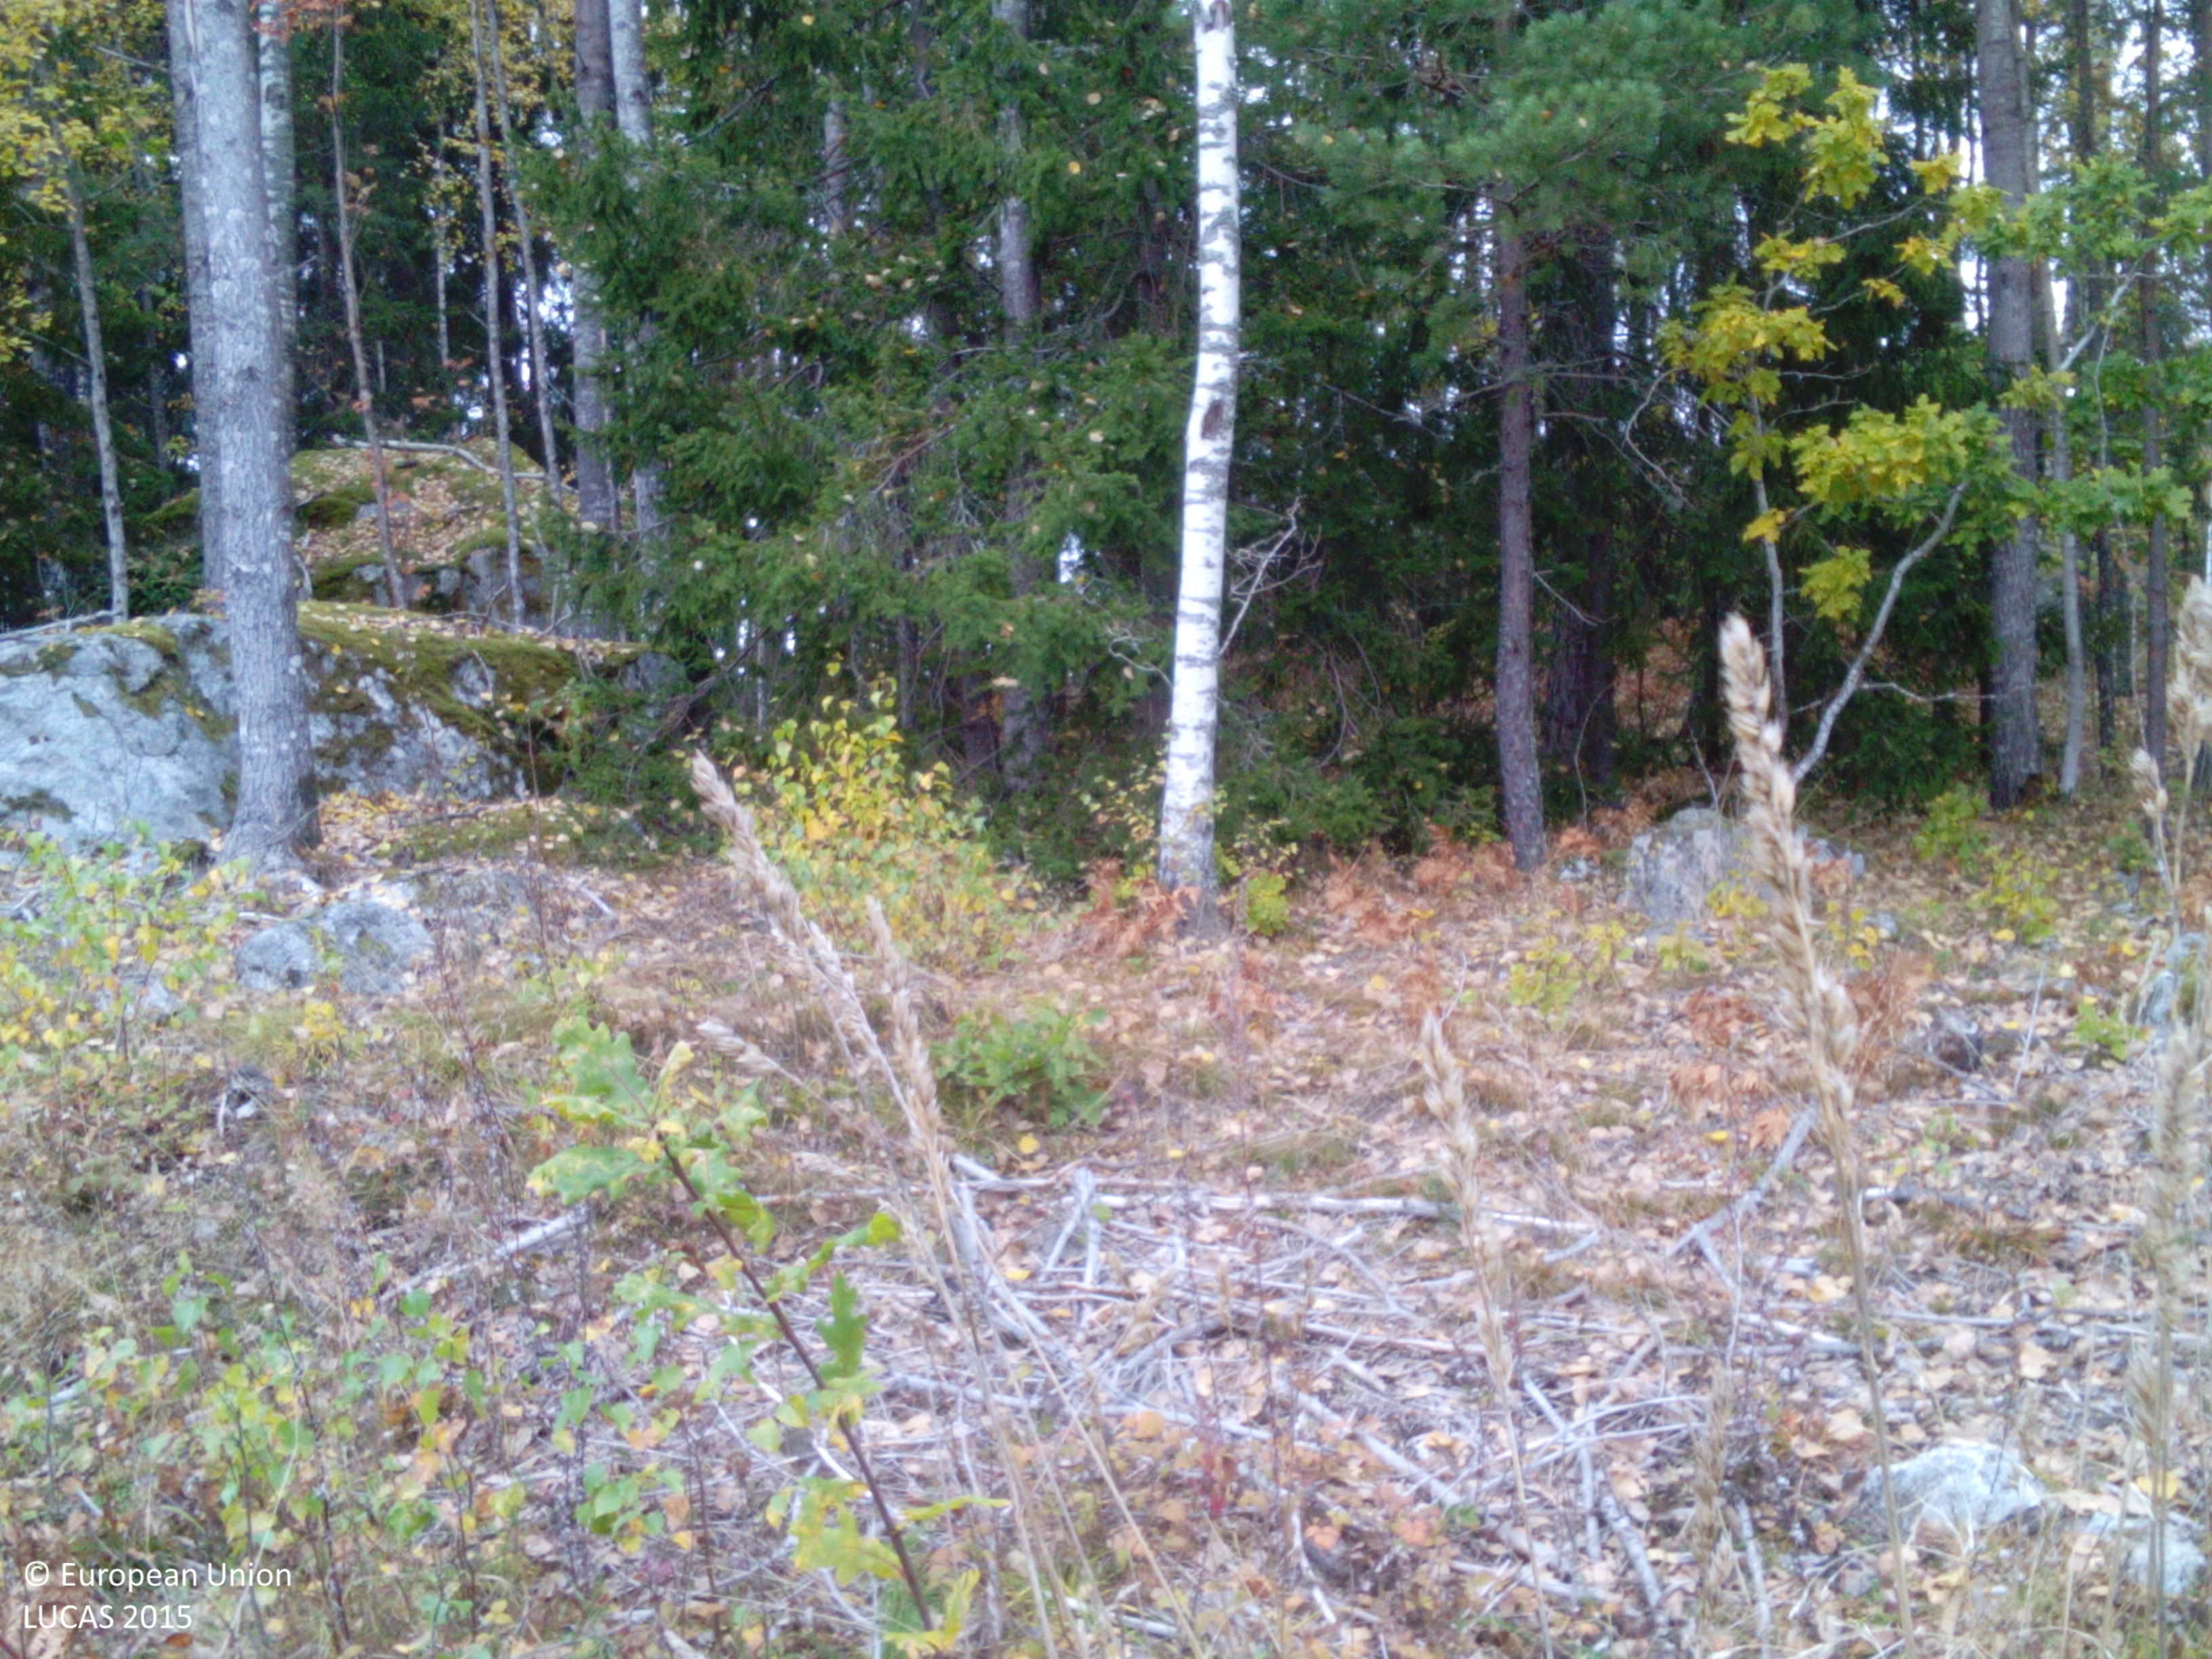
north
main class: Shrubland
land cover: Shrubland with sparse tree cover
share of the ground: 25 - 50 %
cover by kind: shrubs 45 %, herbaceous plants 40 %, broadleaved forest trees 5 %
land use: Semi-natural and natural areas not in use
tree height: < 5 m
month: October
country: SE
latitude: 58.8569
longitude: 16.4957
